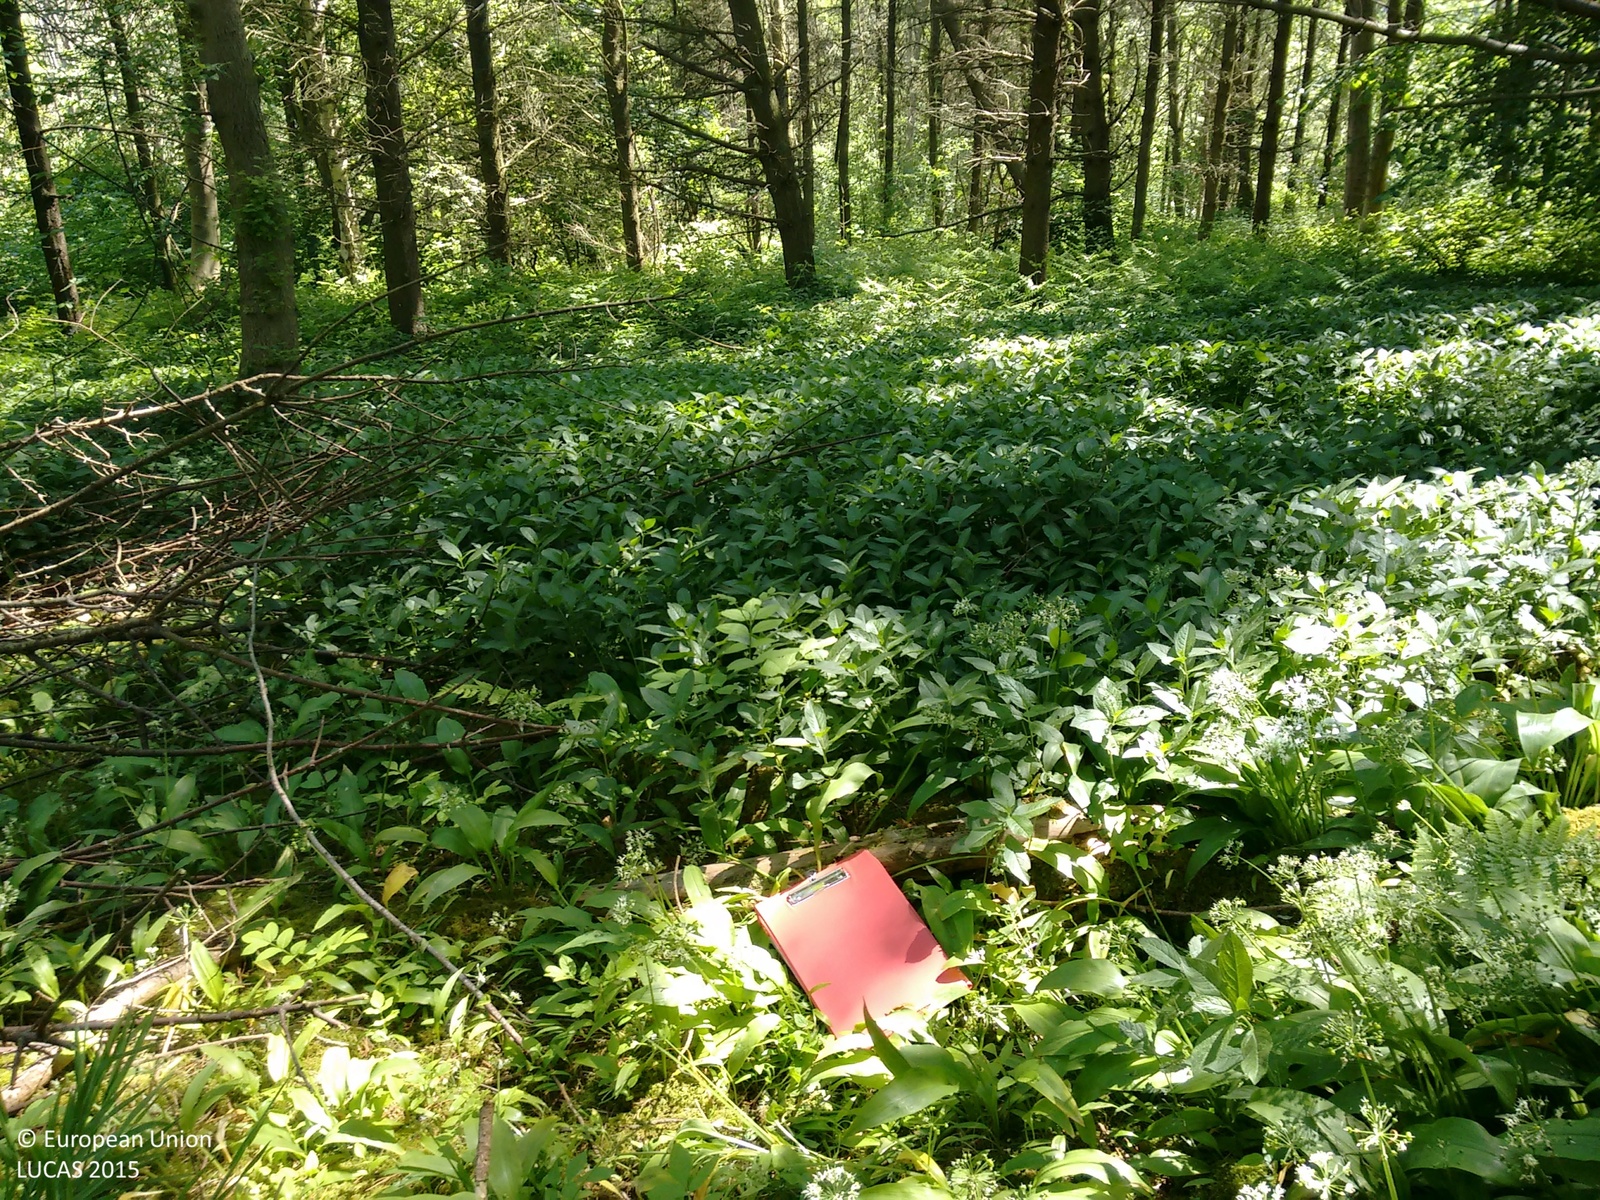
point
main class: Woodland
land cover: Other mixed woodland
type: mesophytic deciduous forest
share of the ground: > 75 %
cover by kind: broadleaved forest trees 55 %, coniferous forest trees 45 %
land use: Forestry
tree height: > 5 m
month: June
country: GB
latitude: 54.0898
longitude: -0.8806
